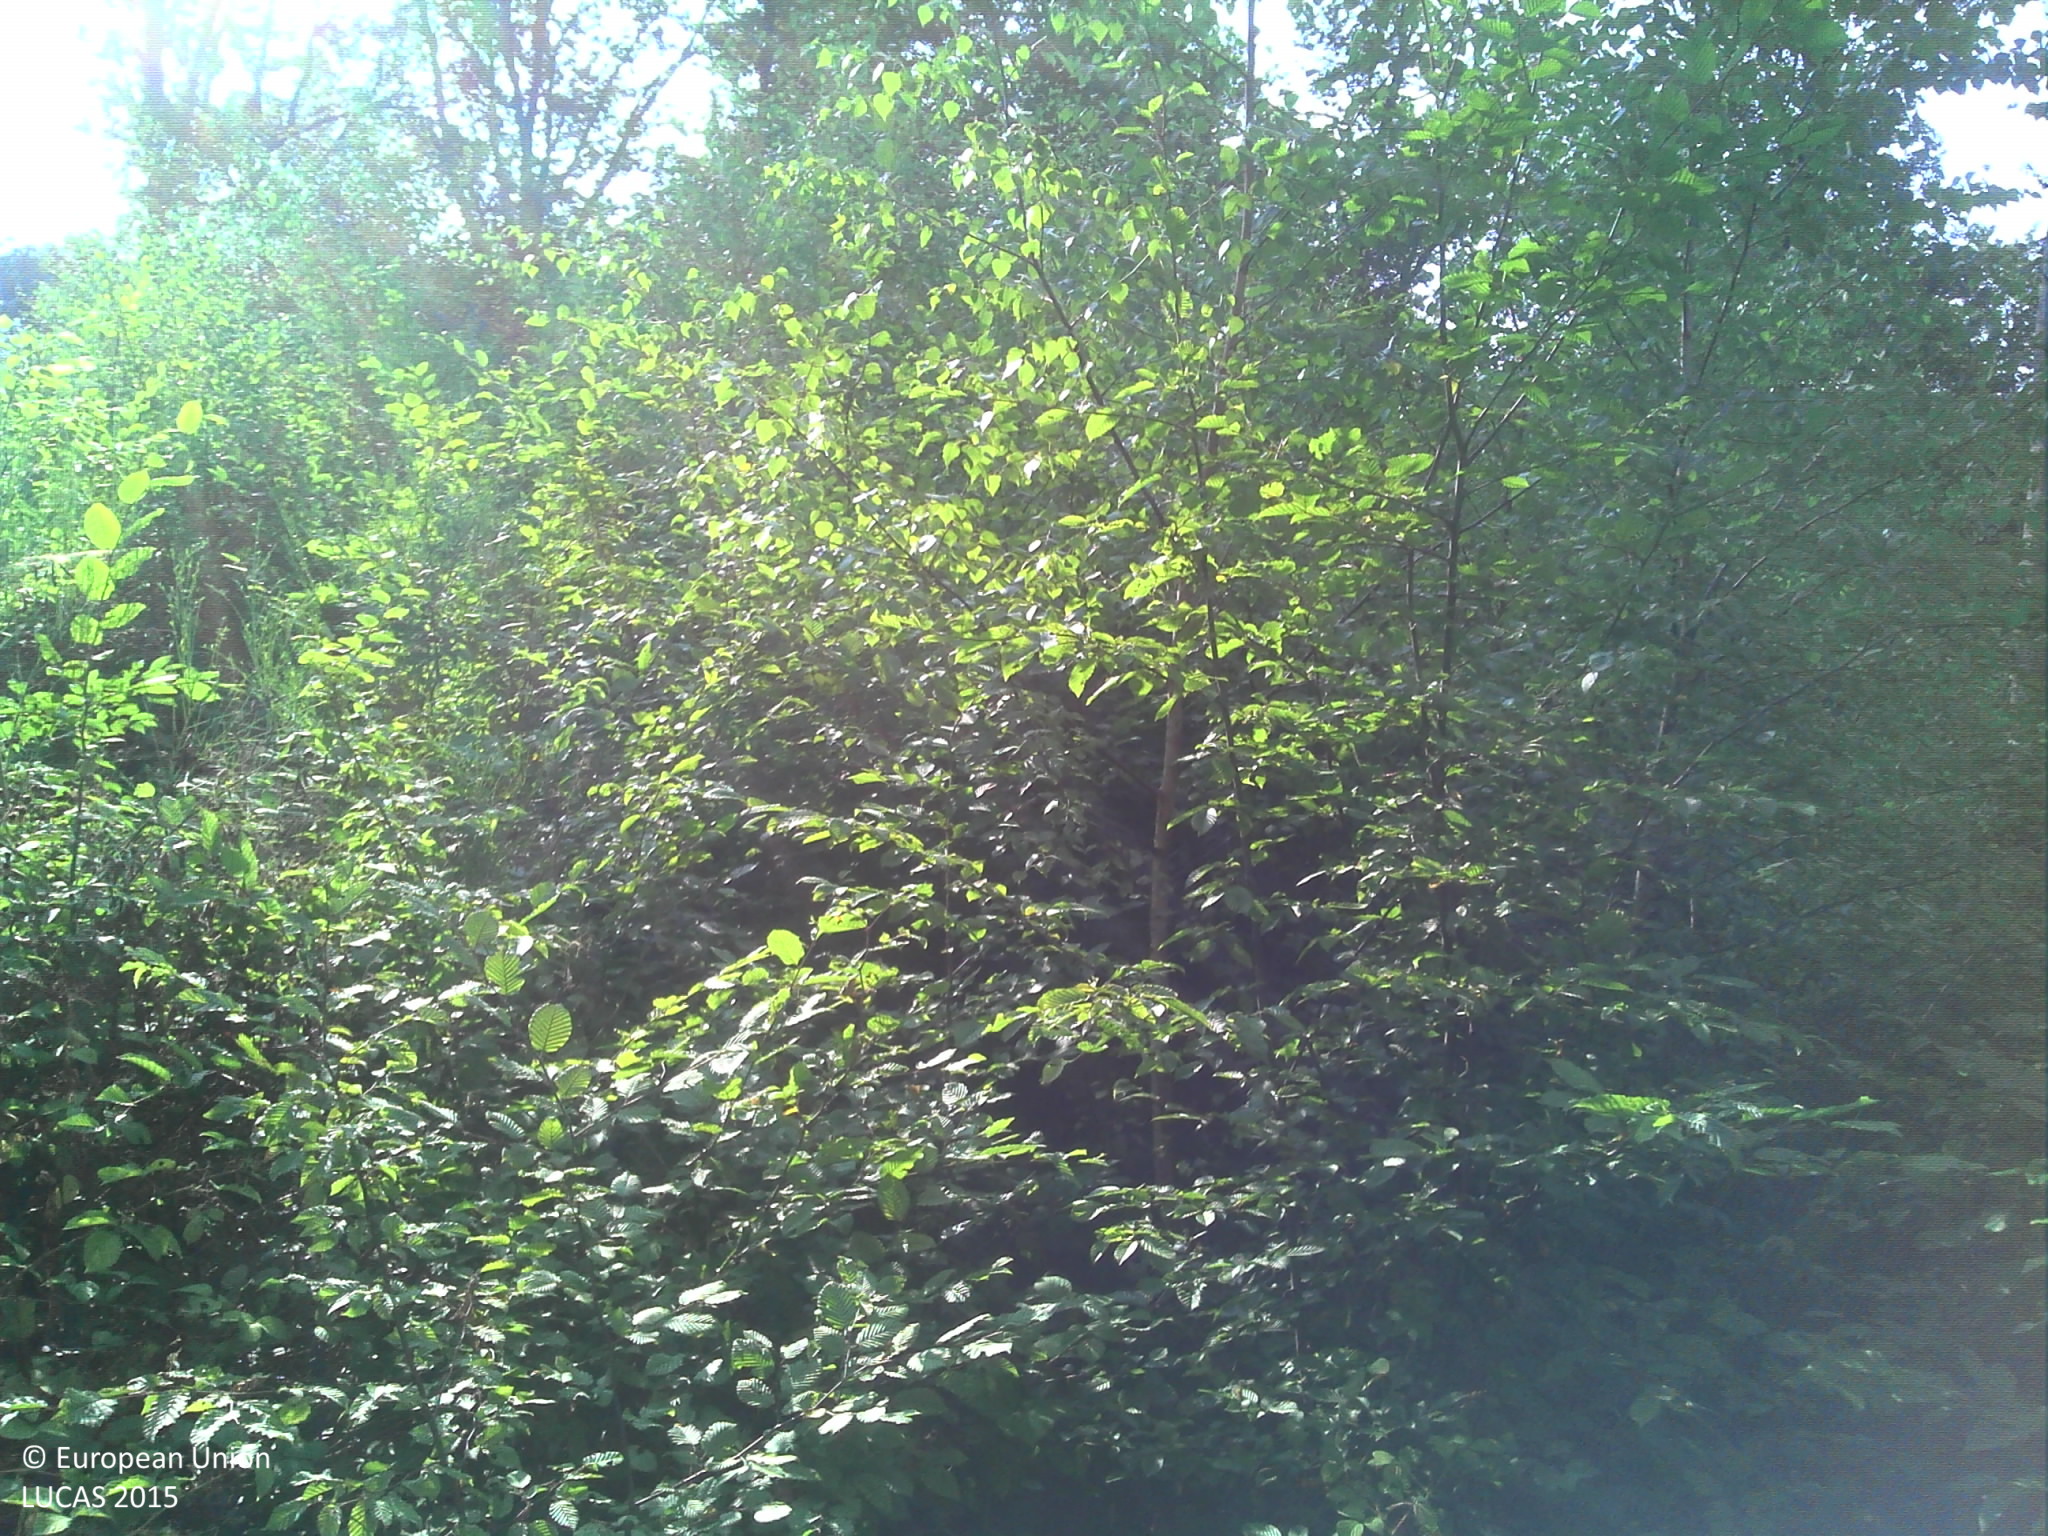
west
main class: Woodland
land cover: Broadleaved woodland
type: mesophytic deciduous forest
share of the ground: > 75 %
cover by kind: broadleaved forest trees 80 %, herbaceous plants 15 %, lichens and mosses 5 %
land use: Semi-natural and natural areas not in use
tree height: > 5 m
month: August
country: FR
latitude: 47.0324
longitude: 4.3545
